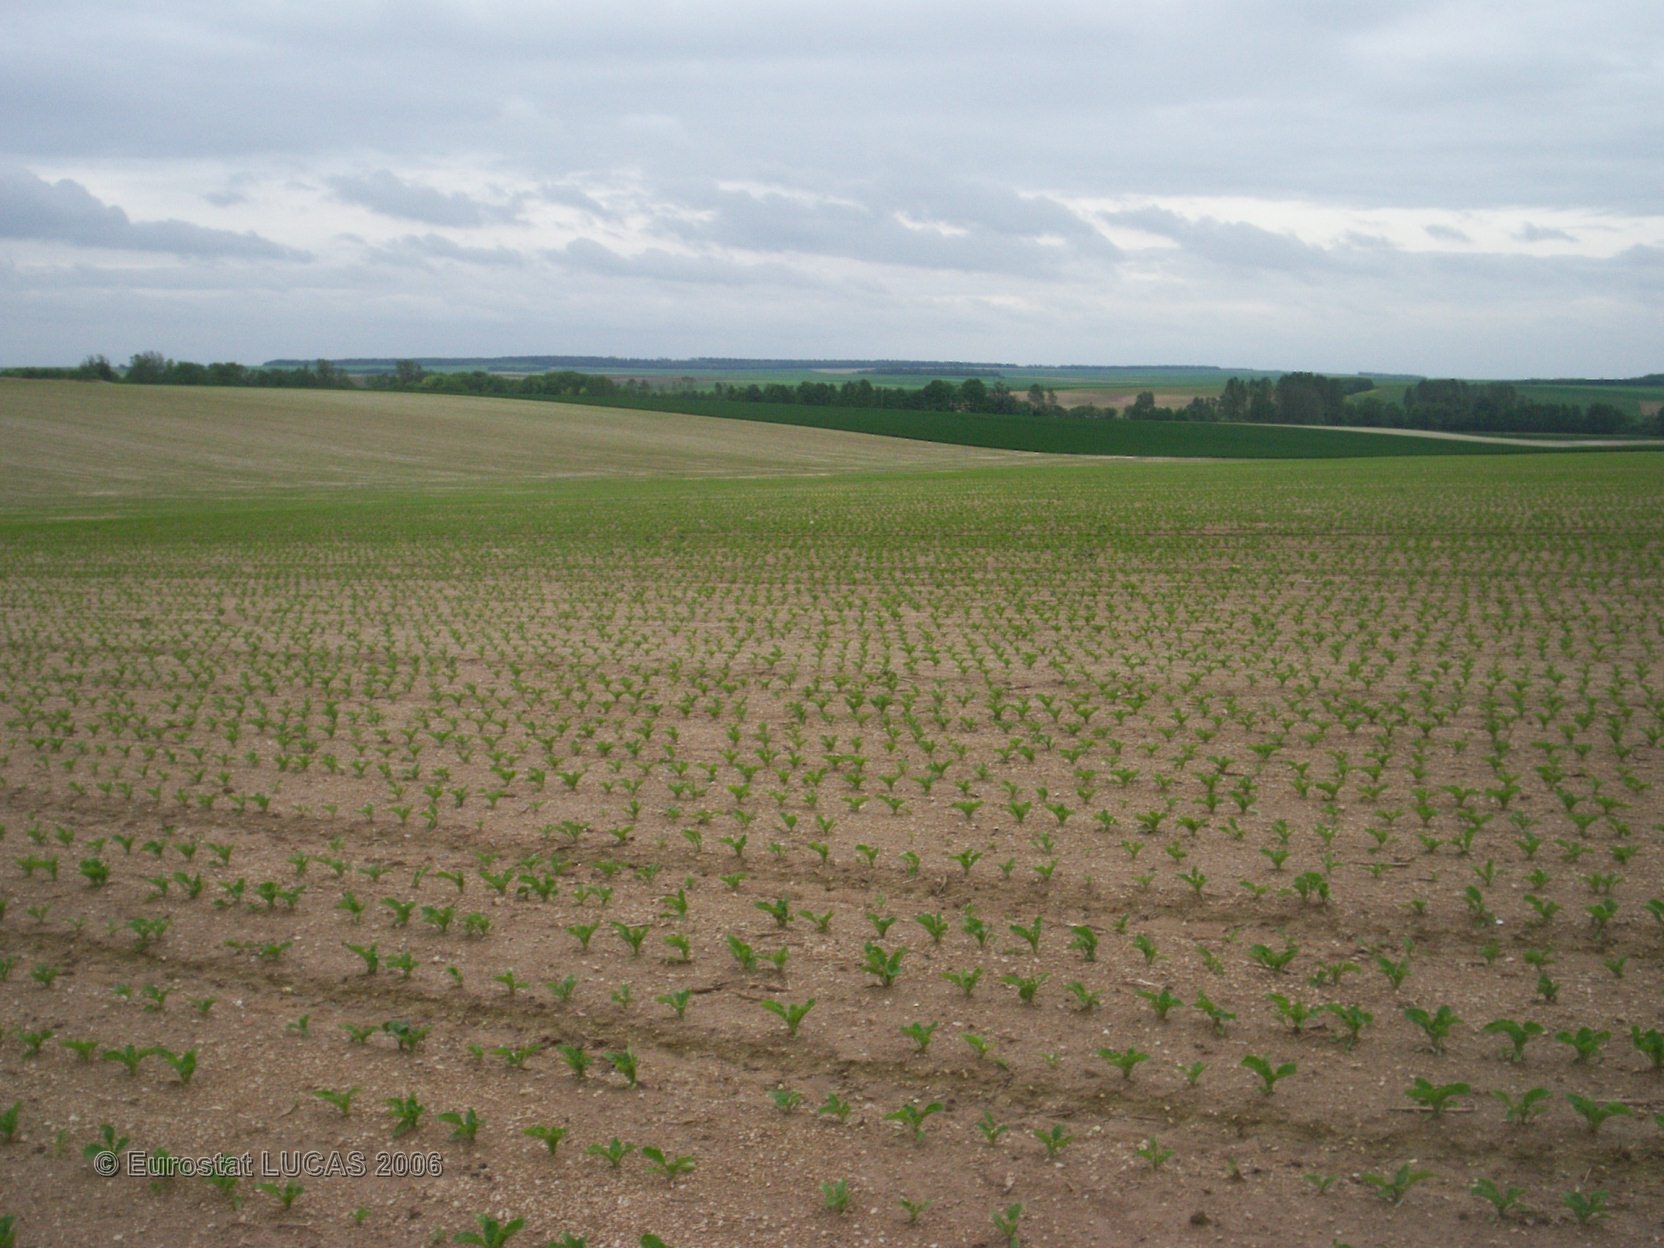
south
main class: Cropland
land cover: Sugar beet
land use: Agriculture (excluding fallow land and kitchen gardens)
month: May
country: FR
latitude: 49.4122
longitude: 4.3309
